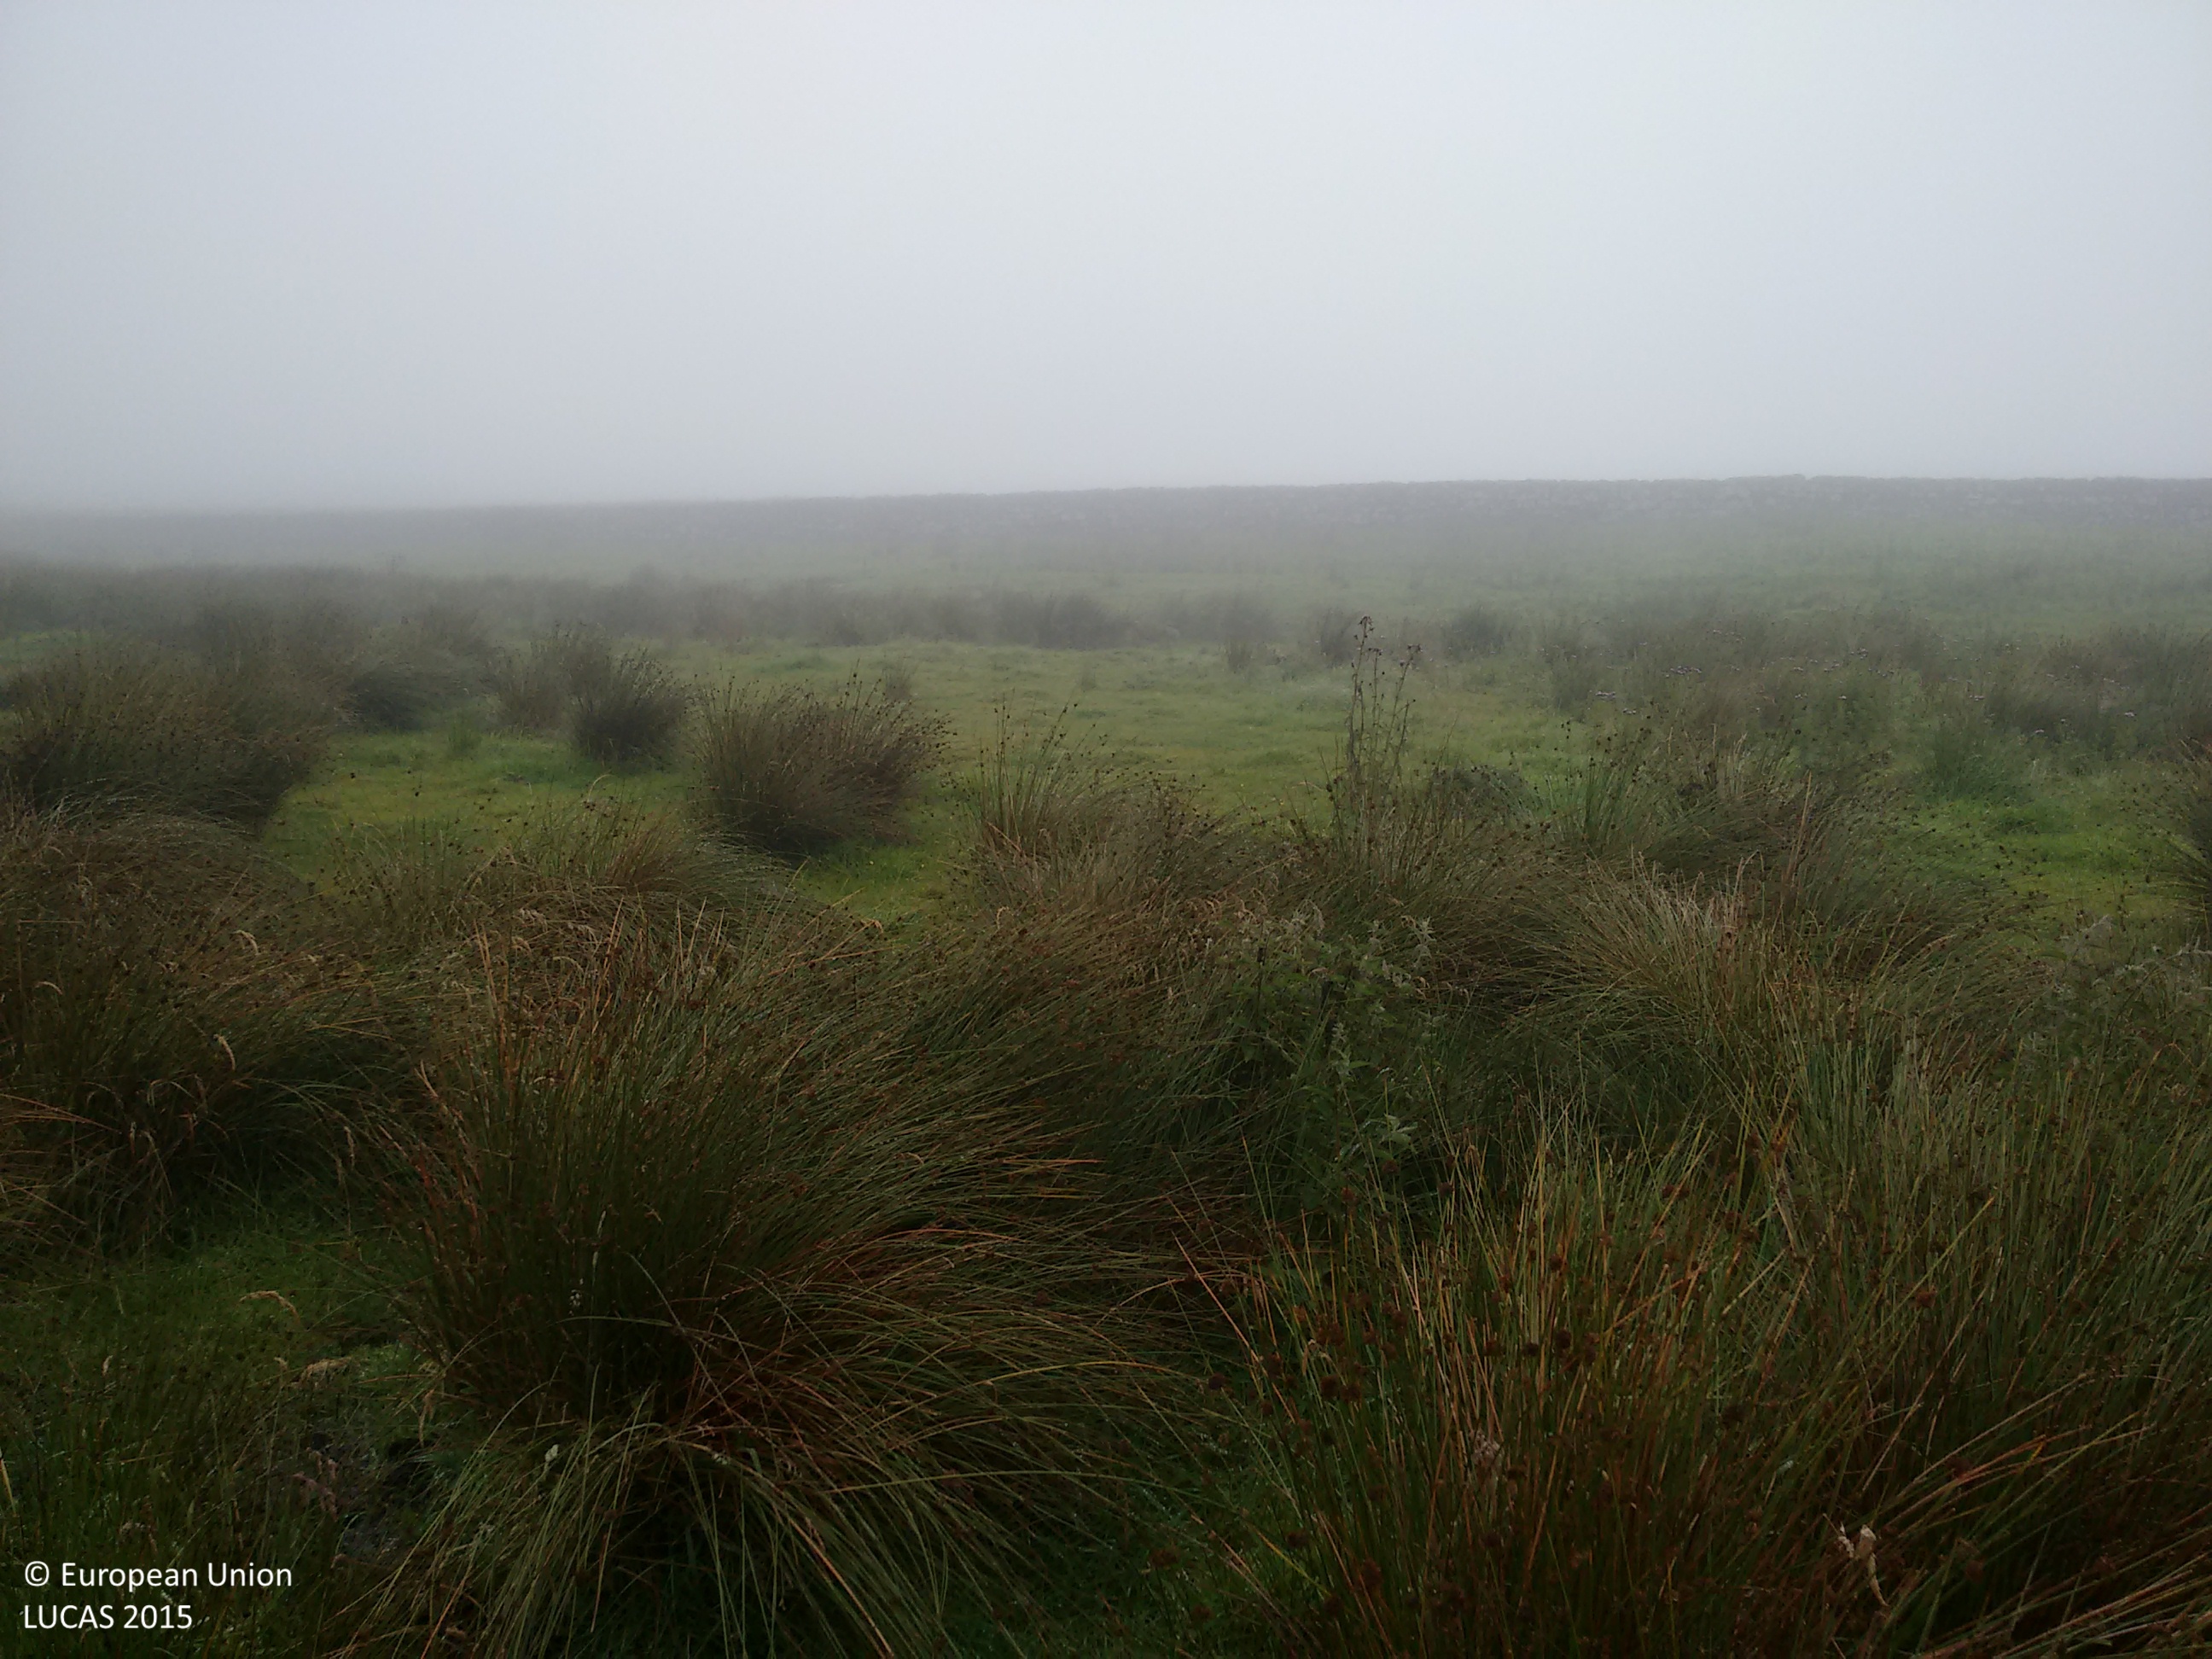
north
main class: Grassland
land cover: Grassland without tree/shrub cover
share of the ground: > 75 %
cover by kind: herbaceous plants 100 %
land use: Agriculture (excluding fallow land and kitchen gardens)
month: August
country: GB
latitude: 50.5567
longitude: -3.9972
